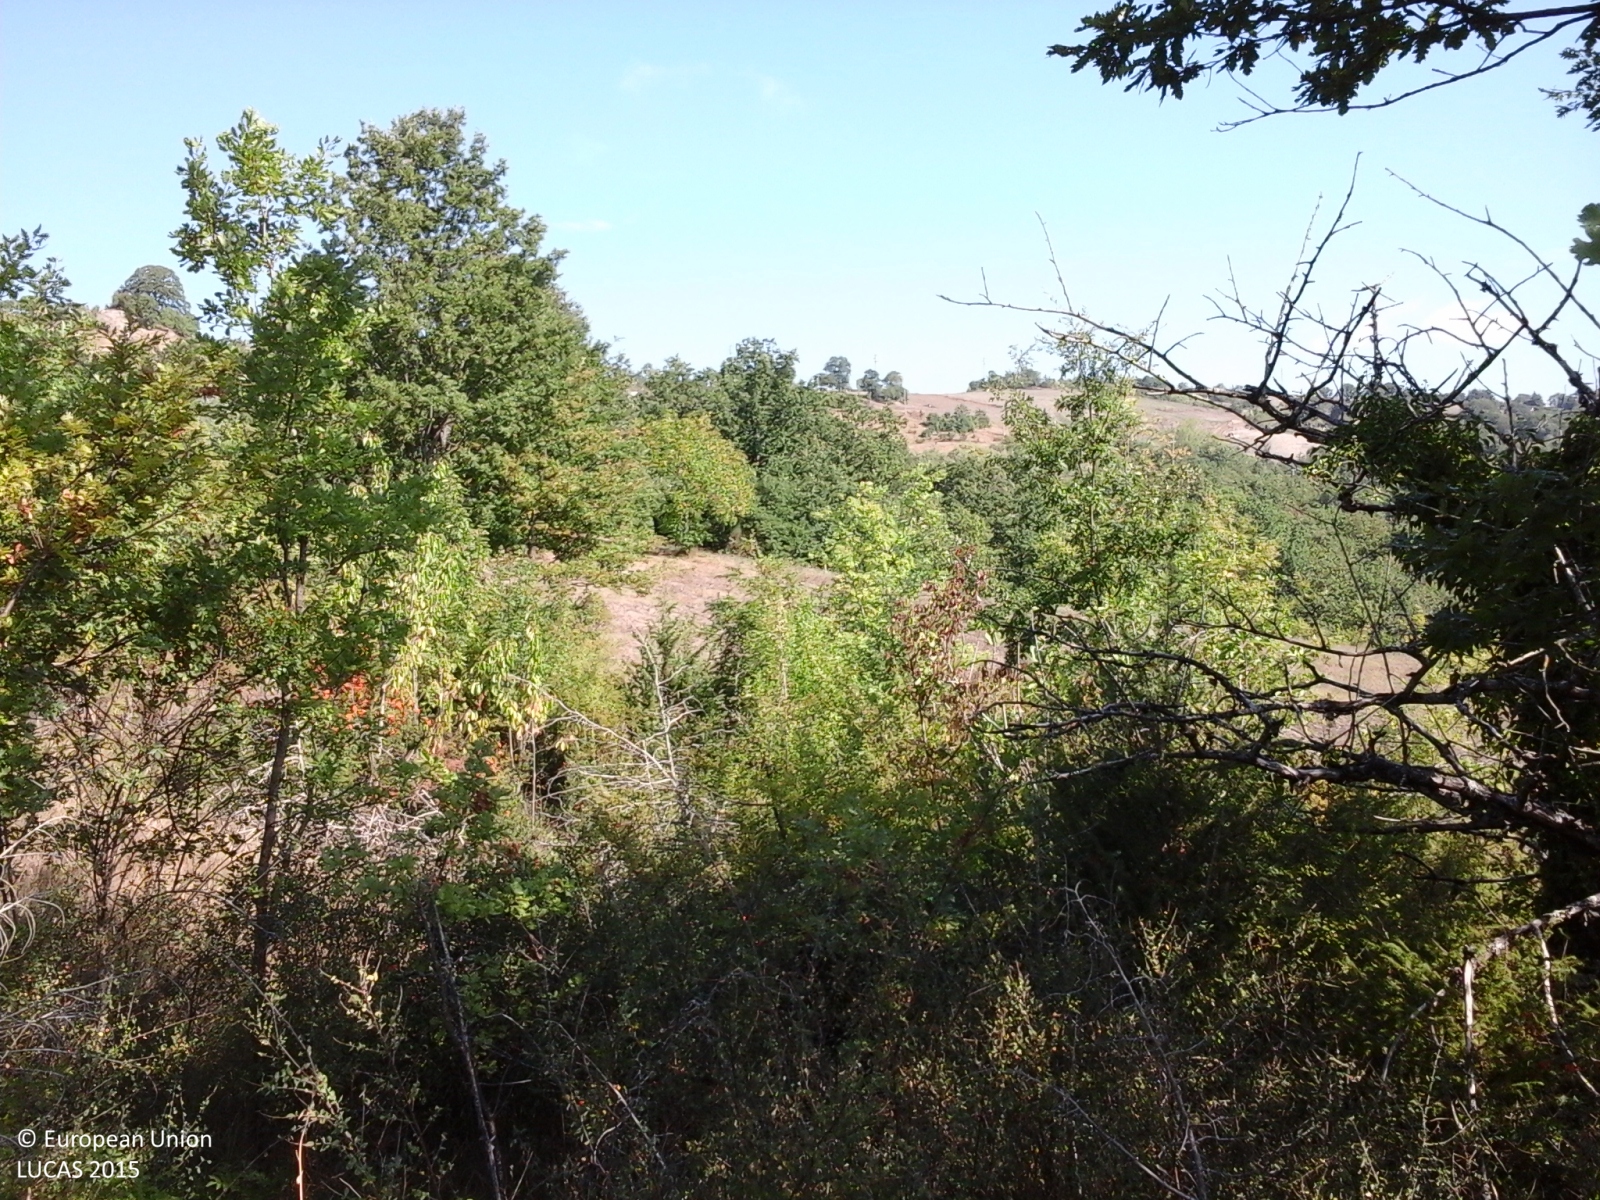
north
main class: Woodland
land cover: Broadleaved woodland
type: thermophilous deciduous forest
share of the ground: > 75 %
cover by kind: broadleaved forest trees 45 %, shrubs 30 %, herbaceous plants 25 %
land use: Semi-natural and natural areas not in use
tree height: > 5 m
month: September
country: IT
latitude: 41.6434
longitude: 14.2231
